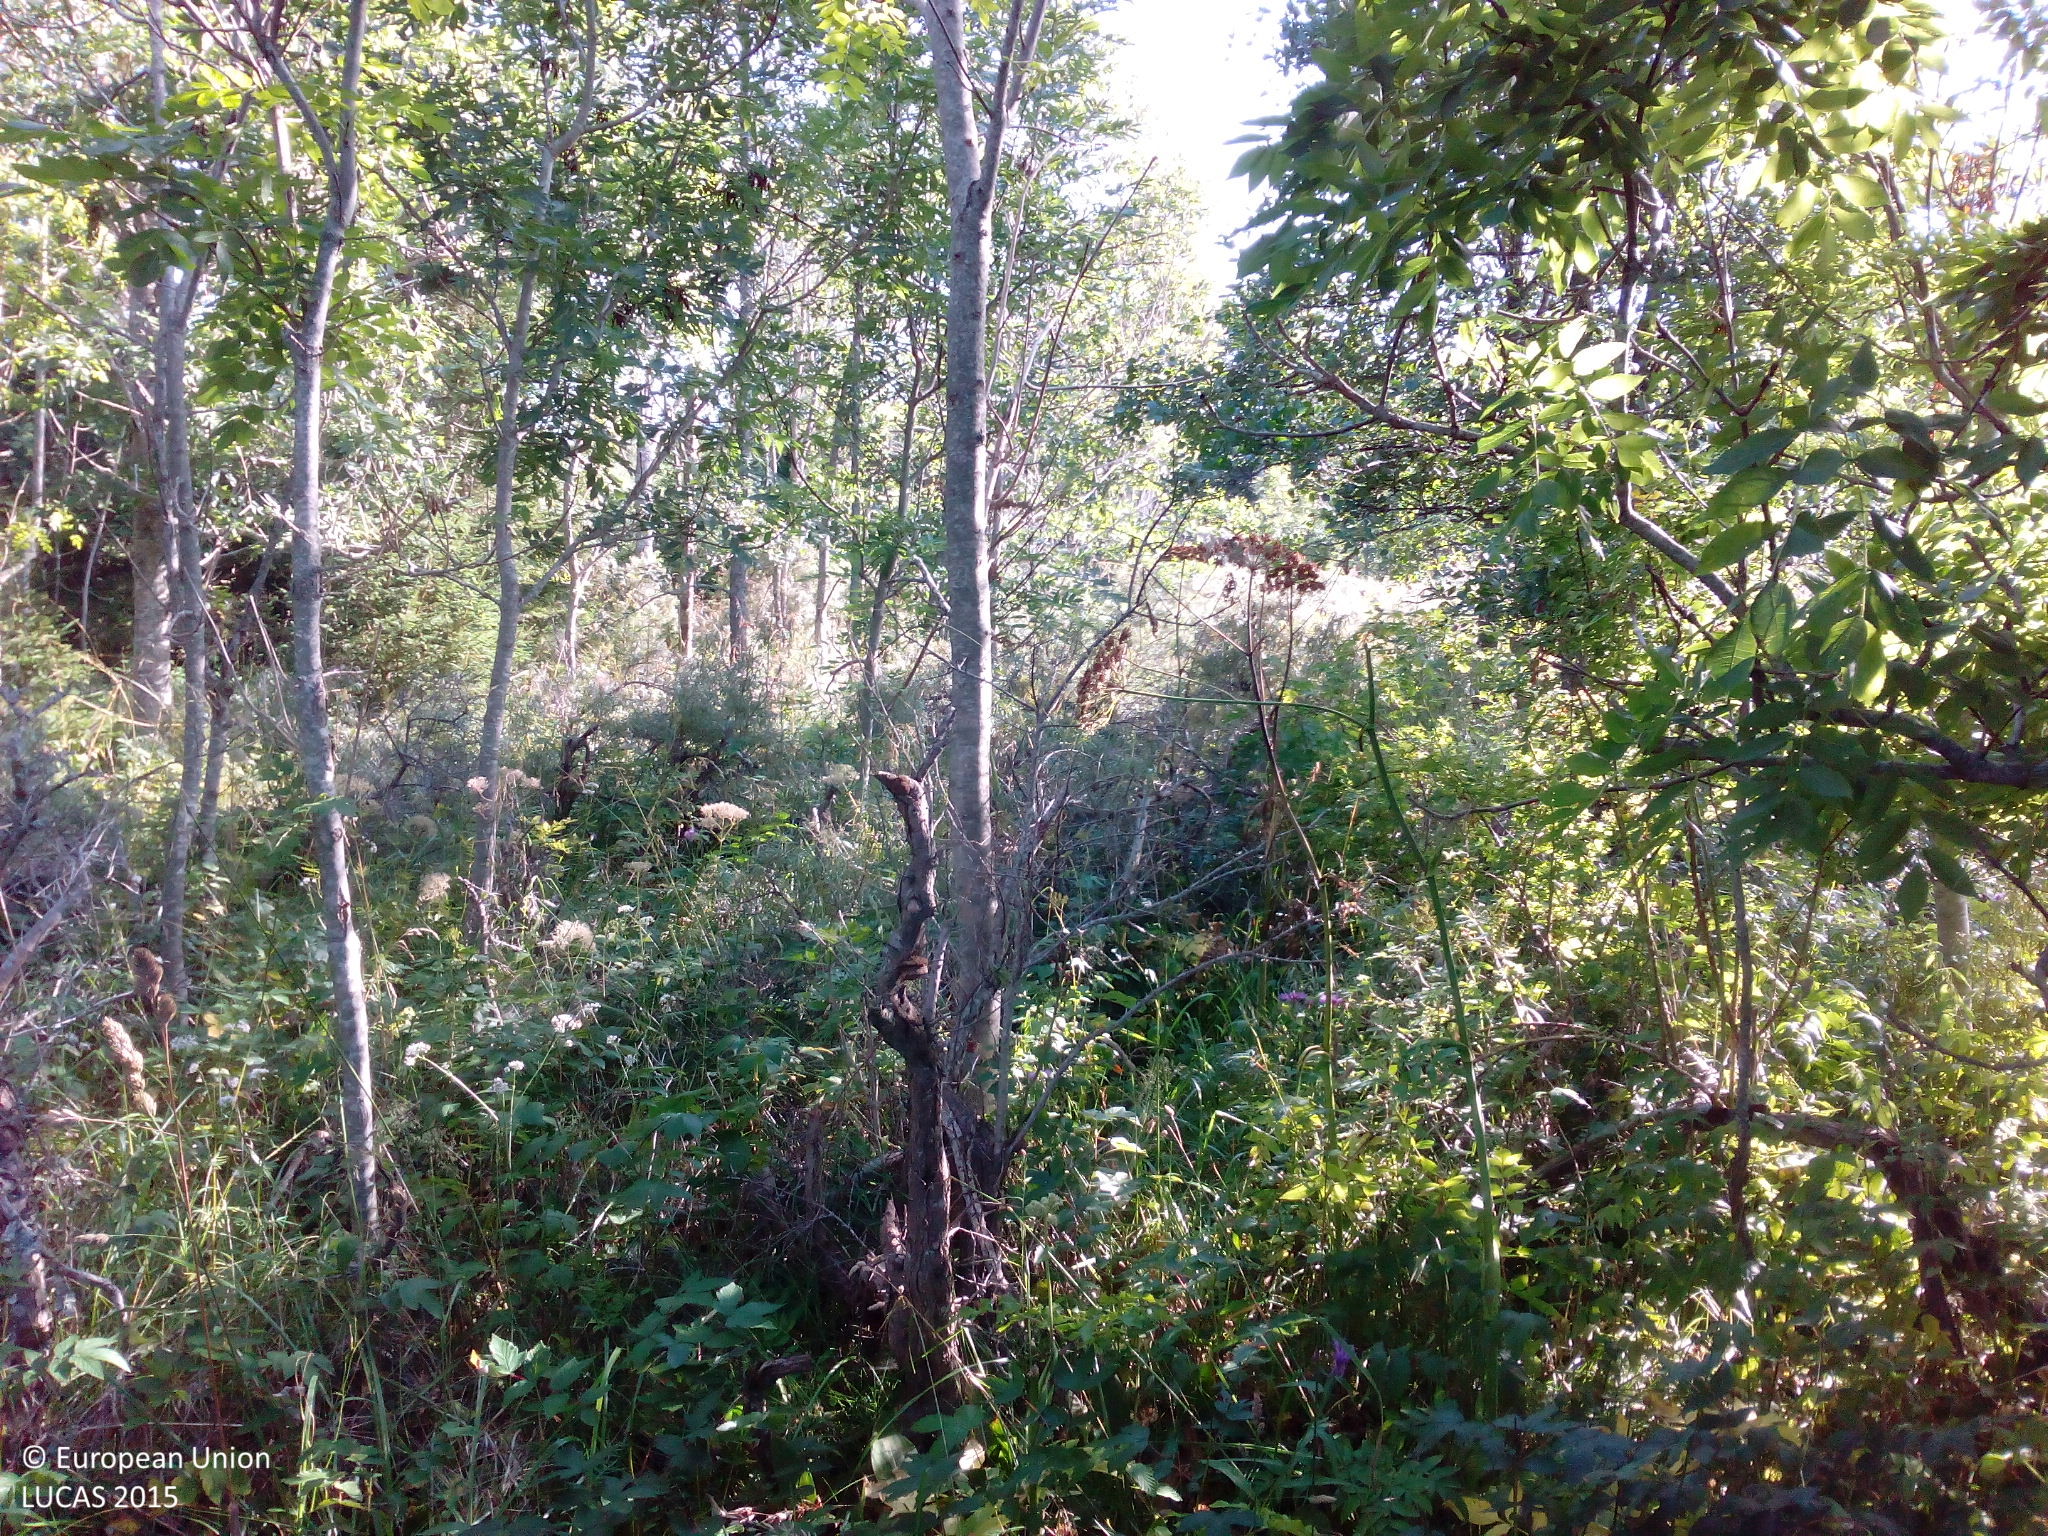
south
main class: Woodland
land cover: Broadleaved woodland
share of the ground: > 75 %
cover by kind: broadleaved forest trees 70 %, herbaceous plants 20 %, coniferous forest trees 10 %
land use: Semi-natural and natural areas not in use
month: August
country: FI
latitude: 60.2983
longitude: 19.7201
